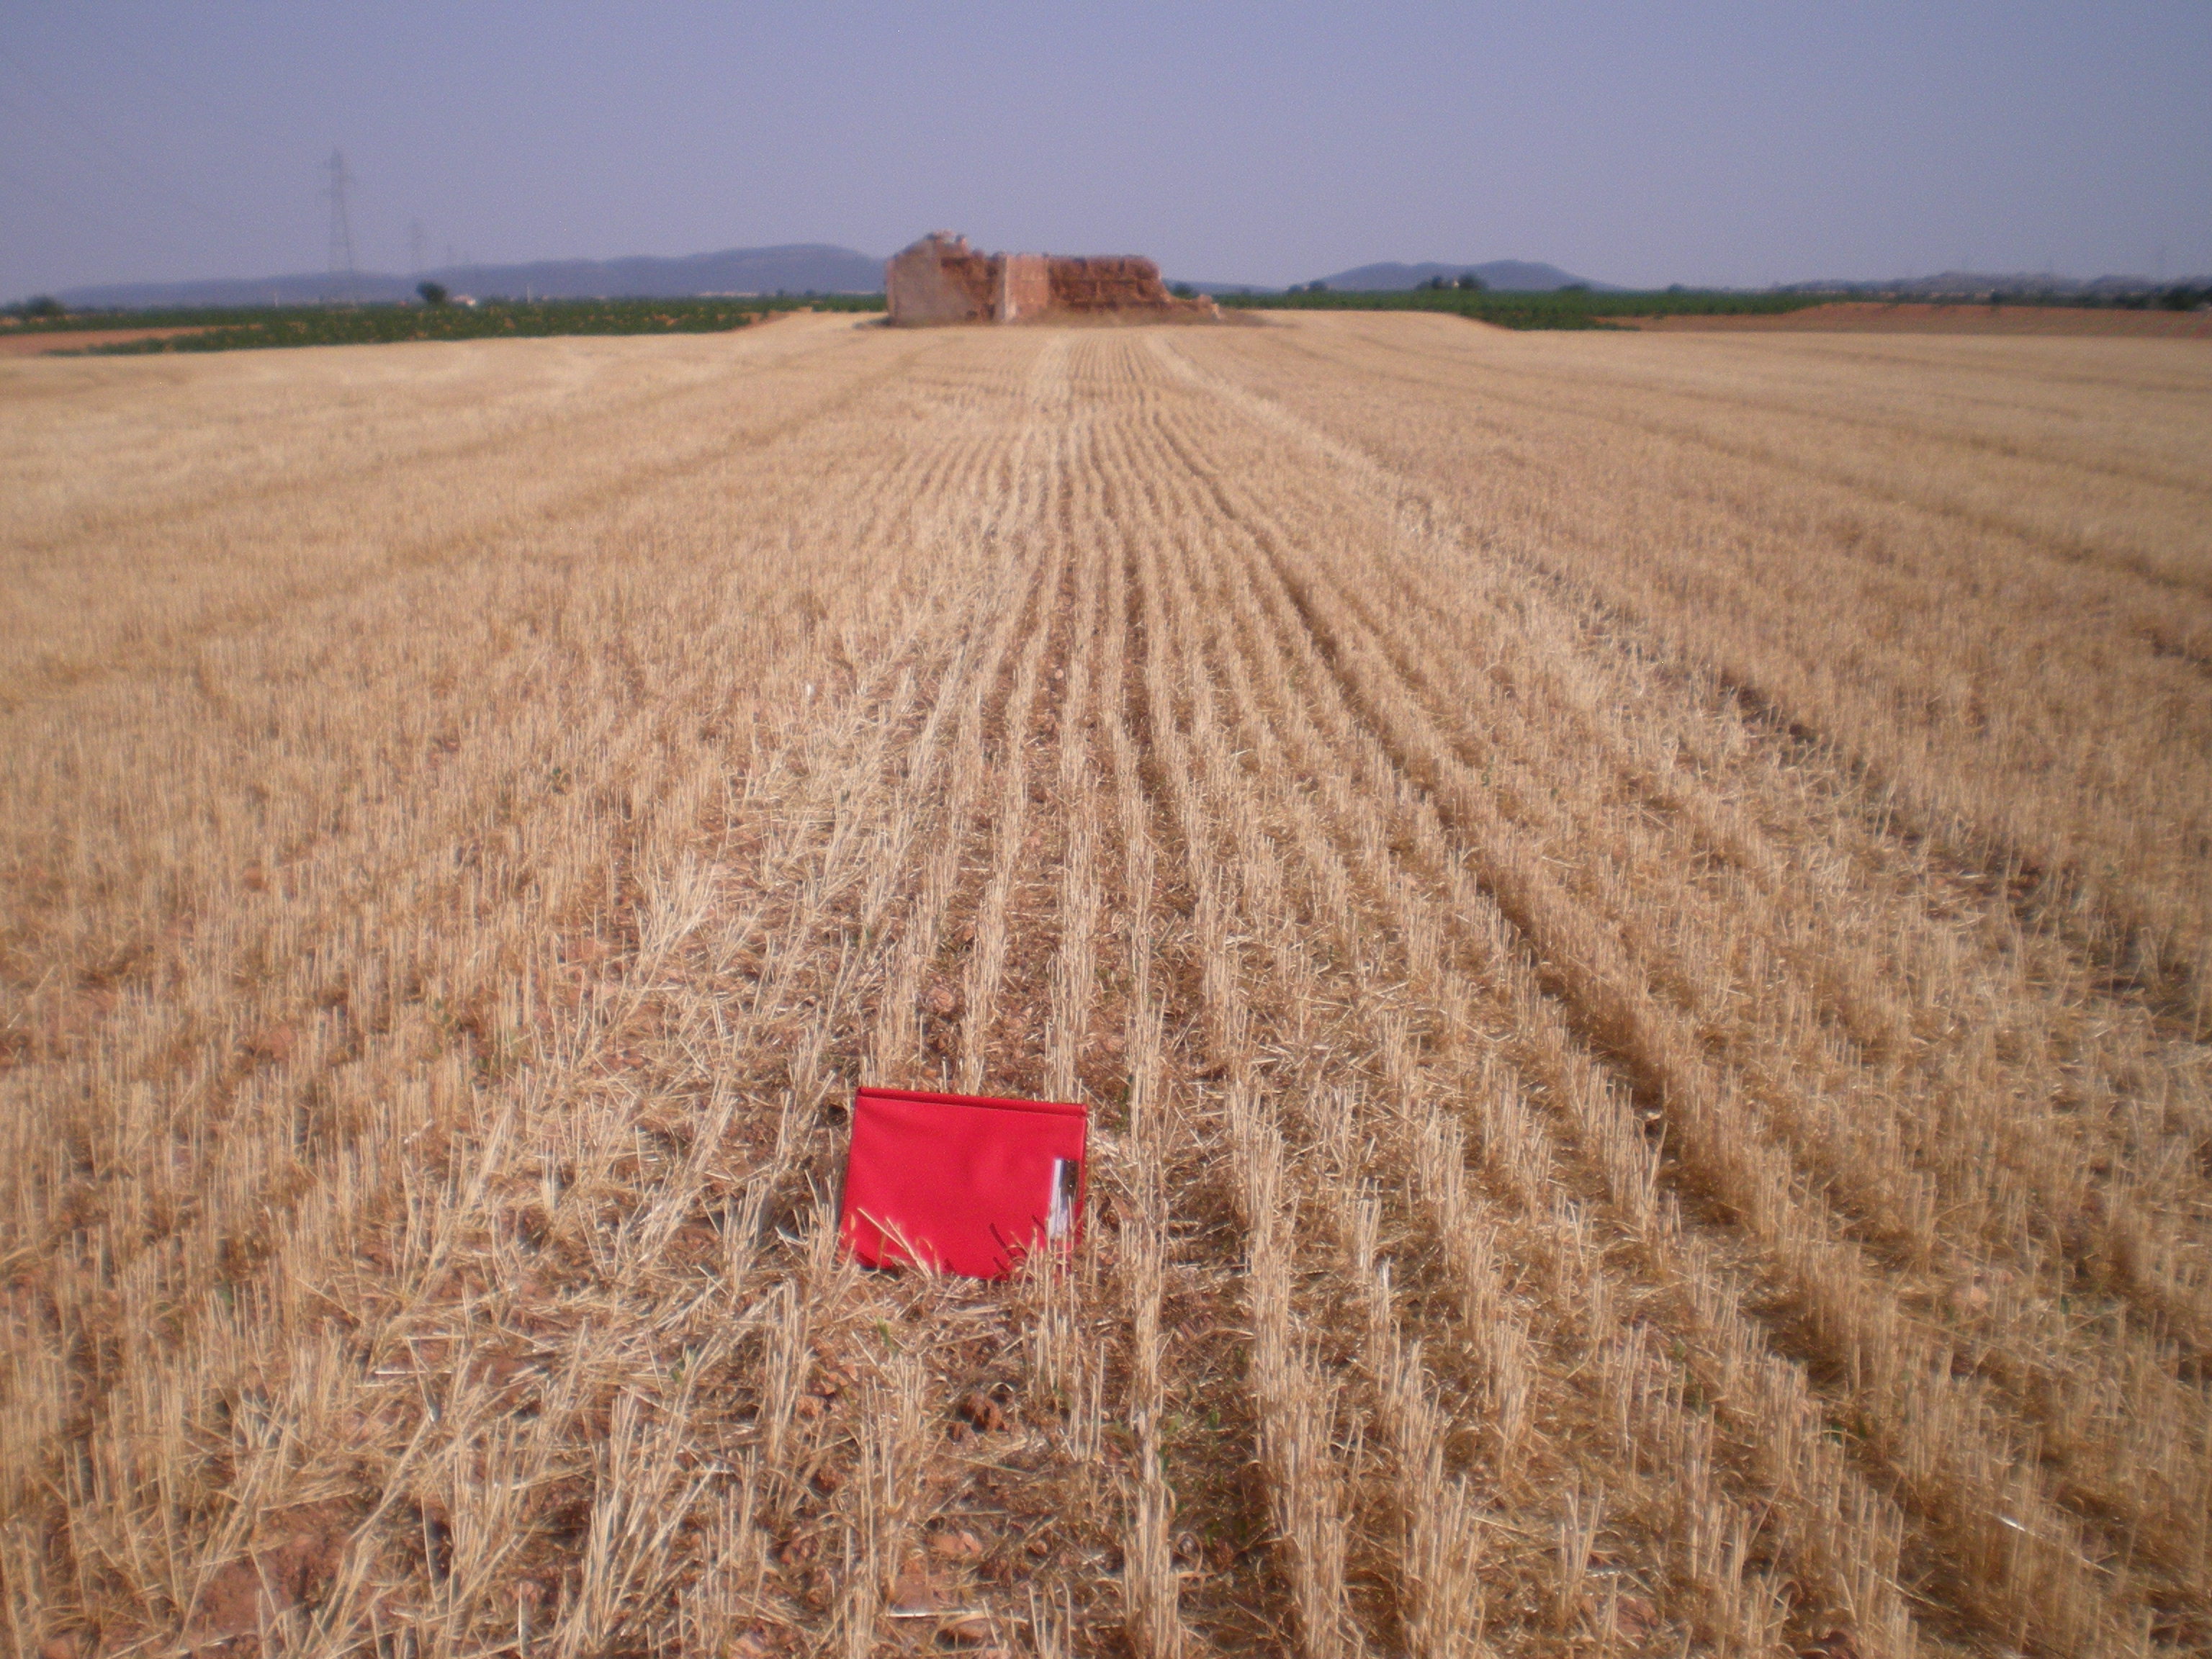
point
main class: Cropland
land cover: Common wheat
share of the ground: < 10 %
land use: Agriculture (excluding fallow land and kitchen gardens)
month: July
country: ES
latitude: 39.4201
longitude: -3.5074
